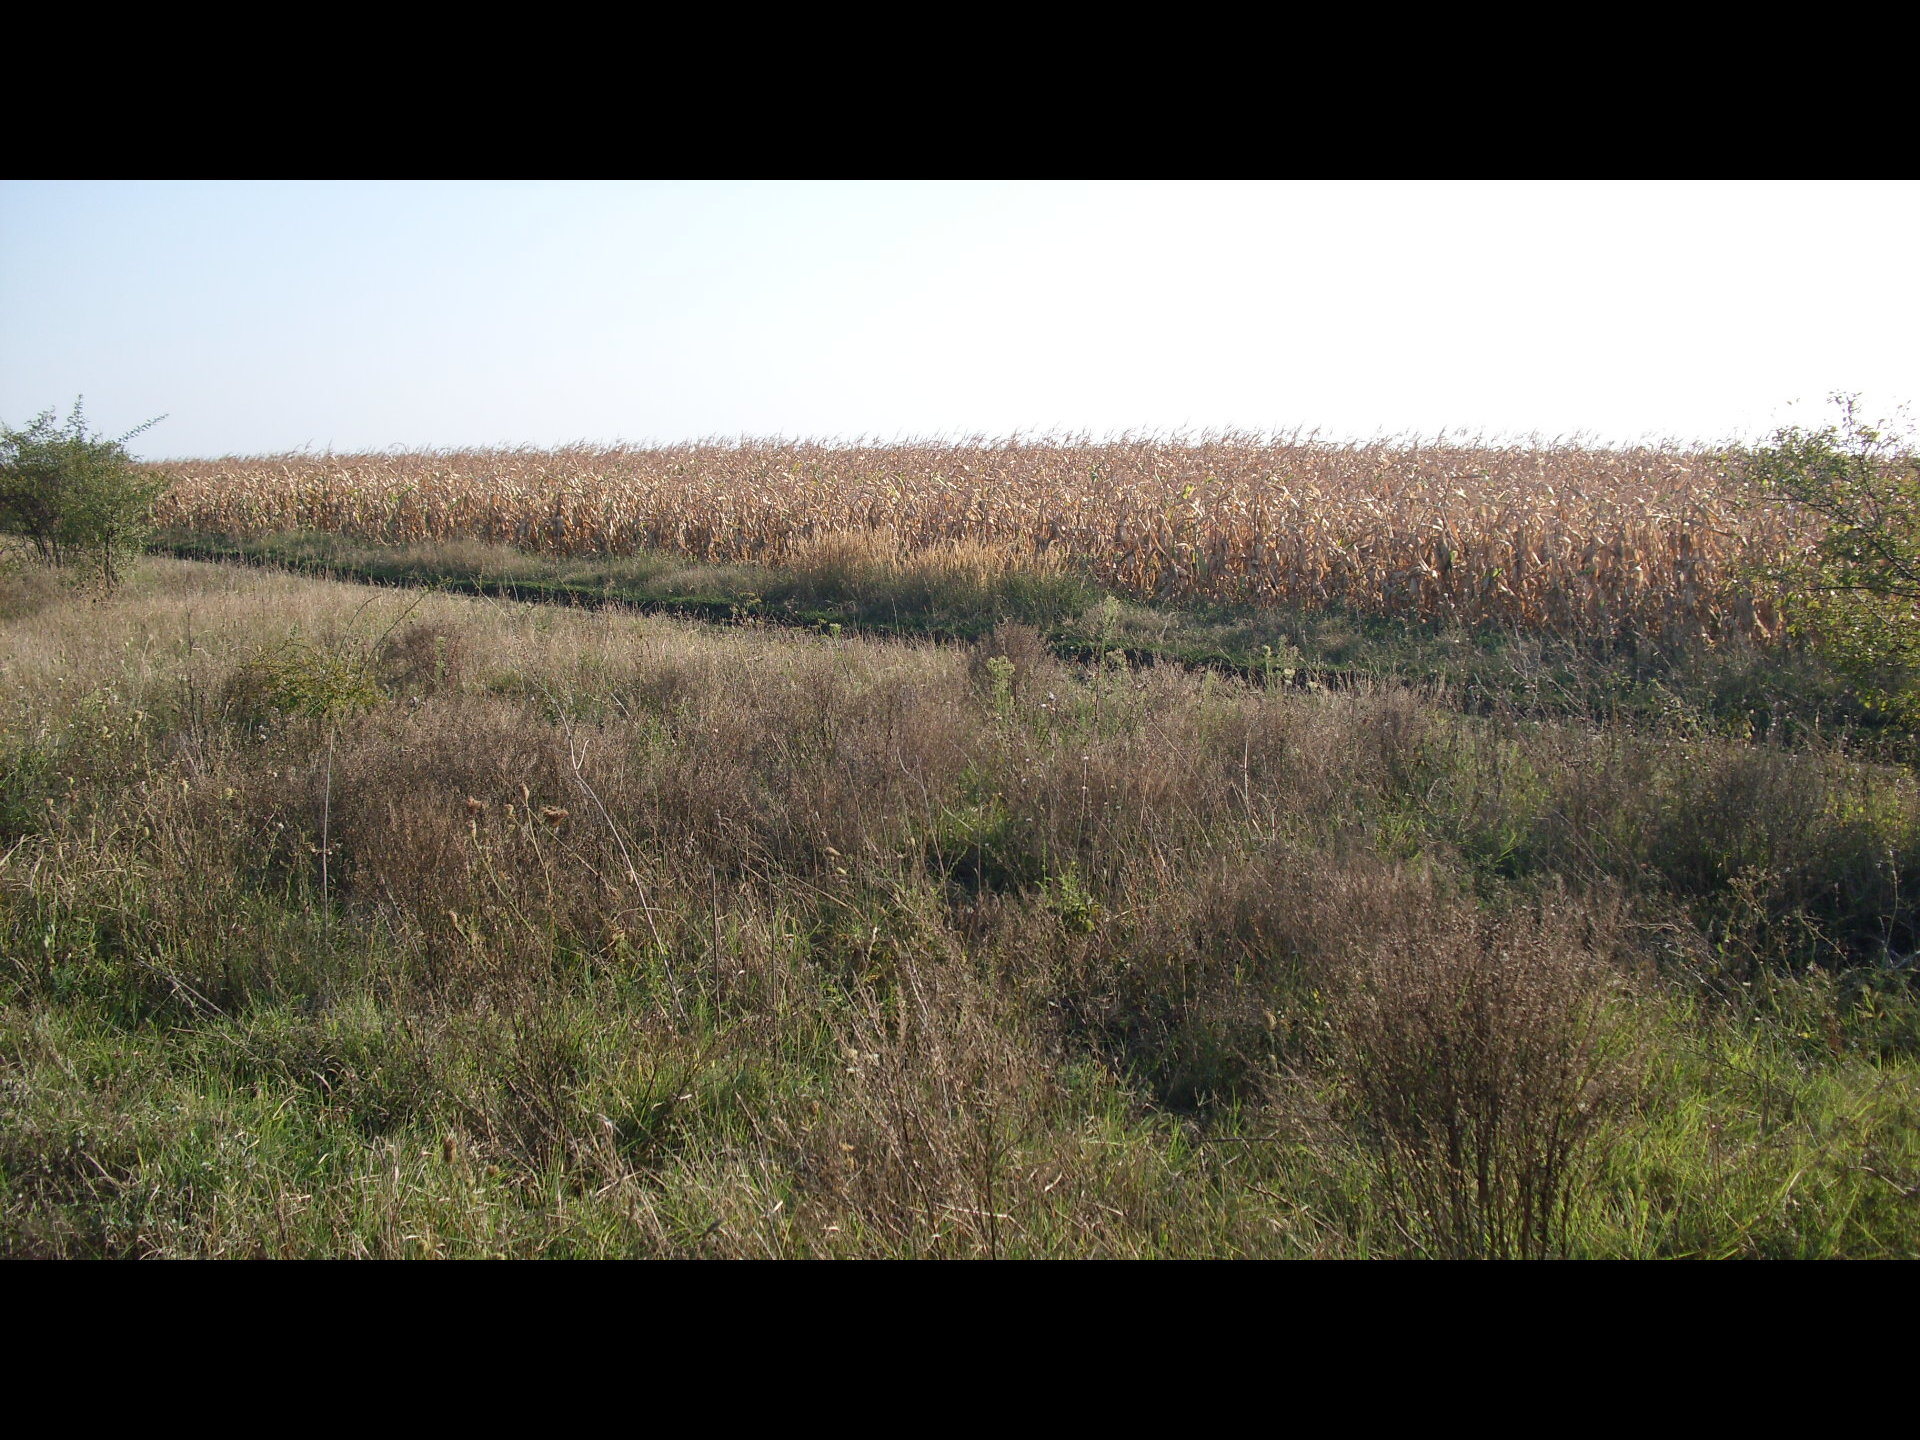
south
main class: Cropland
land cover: Maize
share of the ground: > 75 %
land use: Agriculture (excluding fallow land and kitchen gardens)
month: September
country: BG
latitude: 43.9669
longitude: 22.5613
